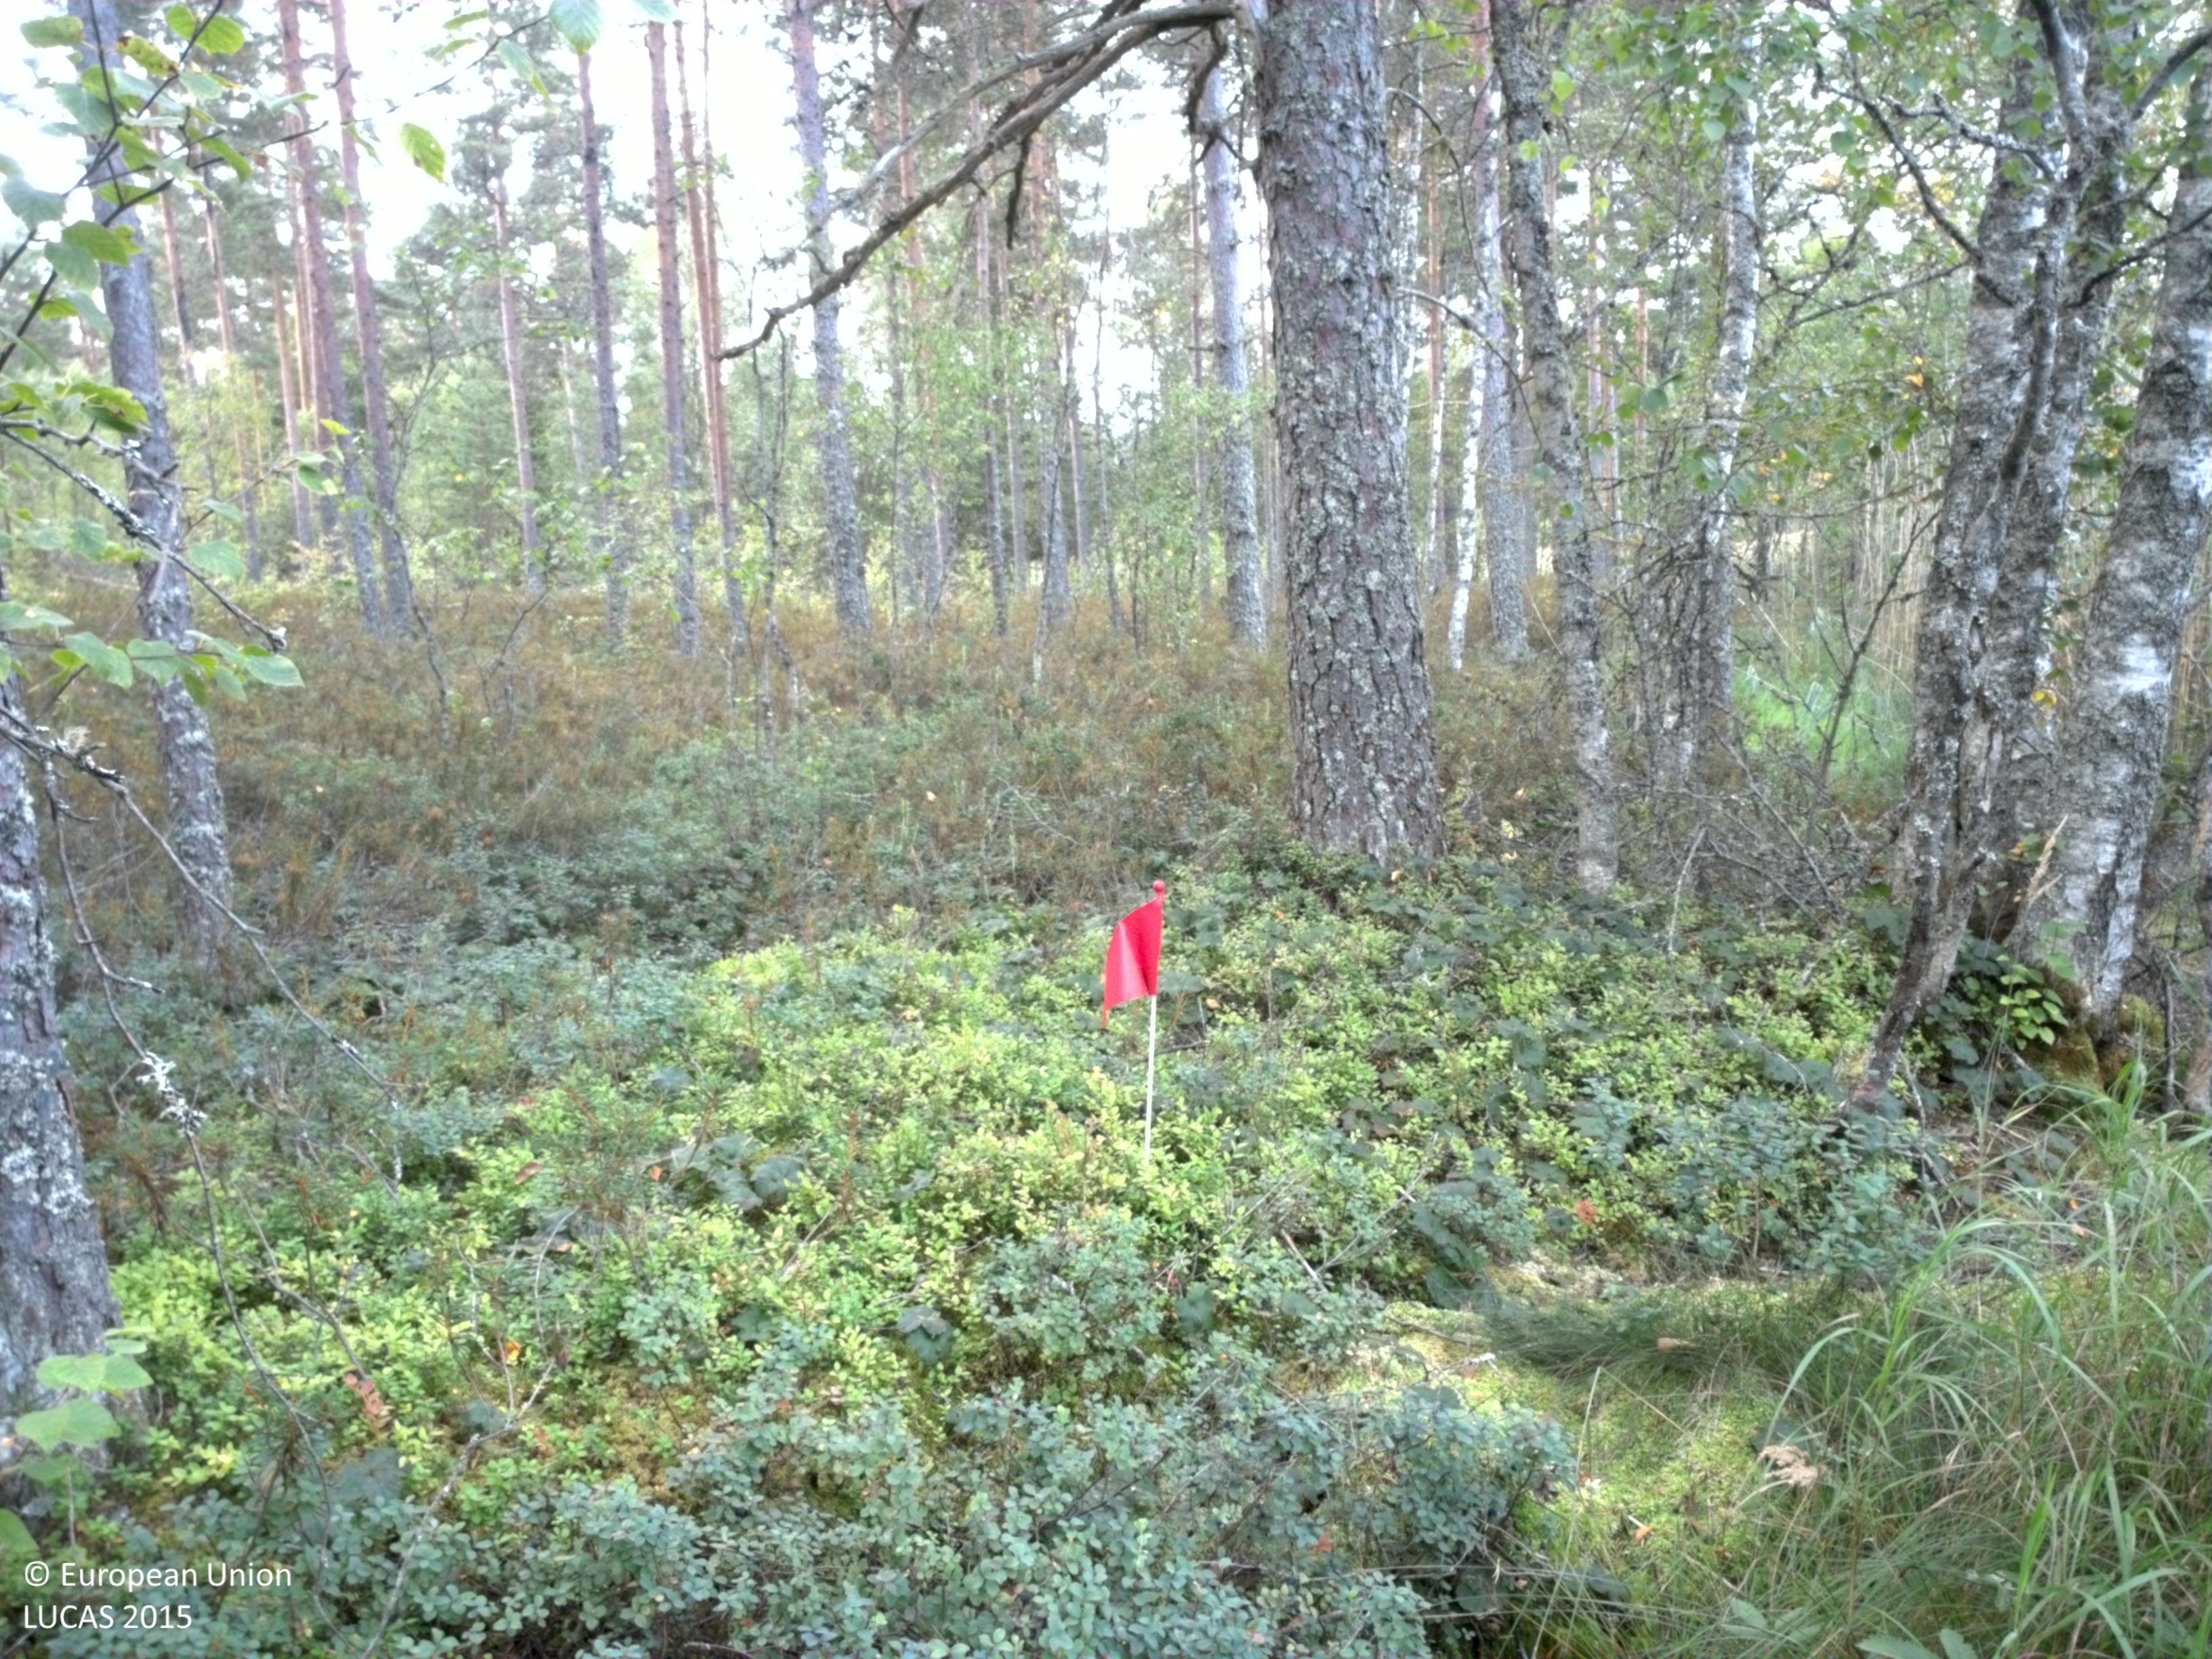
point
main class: Woodland
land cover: Pine dominated coniferous woodland
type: boreal forest
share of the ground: 50 - 75 %
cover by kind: coniferous forest trees 55 %, shrubs 20 %, broadleaved forest trees 10 %, lichens and mosses 10 %, herbaceous plants 5 %
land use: Forestry
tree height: > 5 m
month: August
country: SE
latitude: 59.5801
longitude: 13.4445
